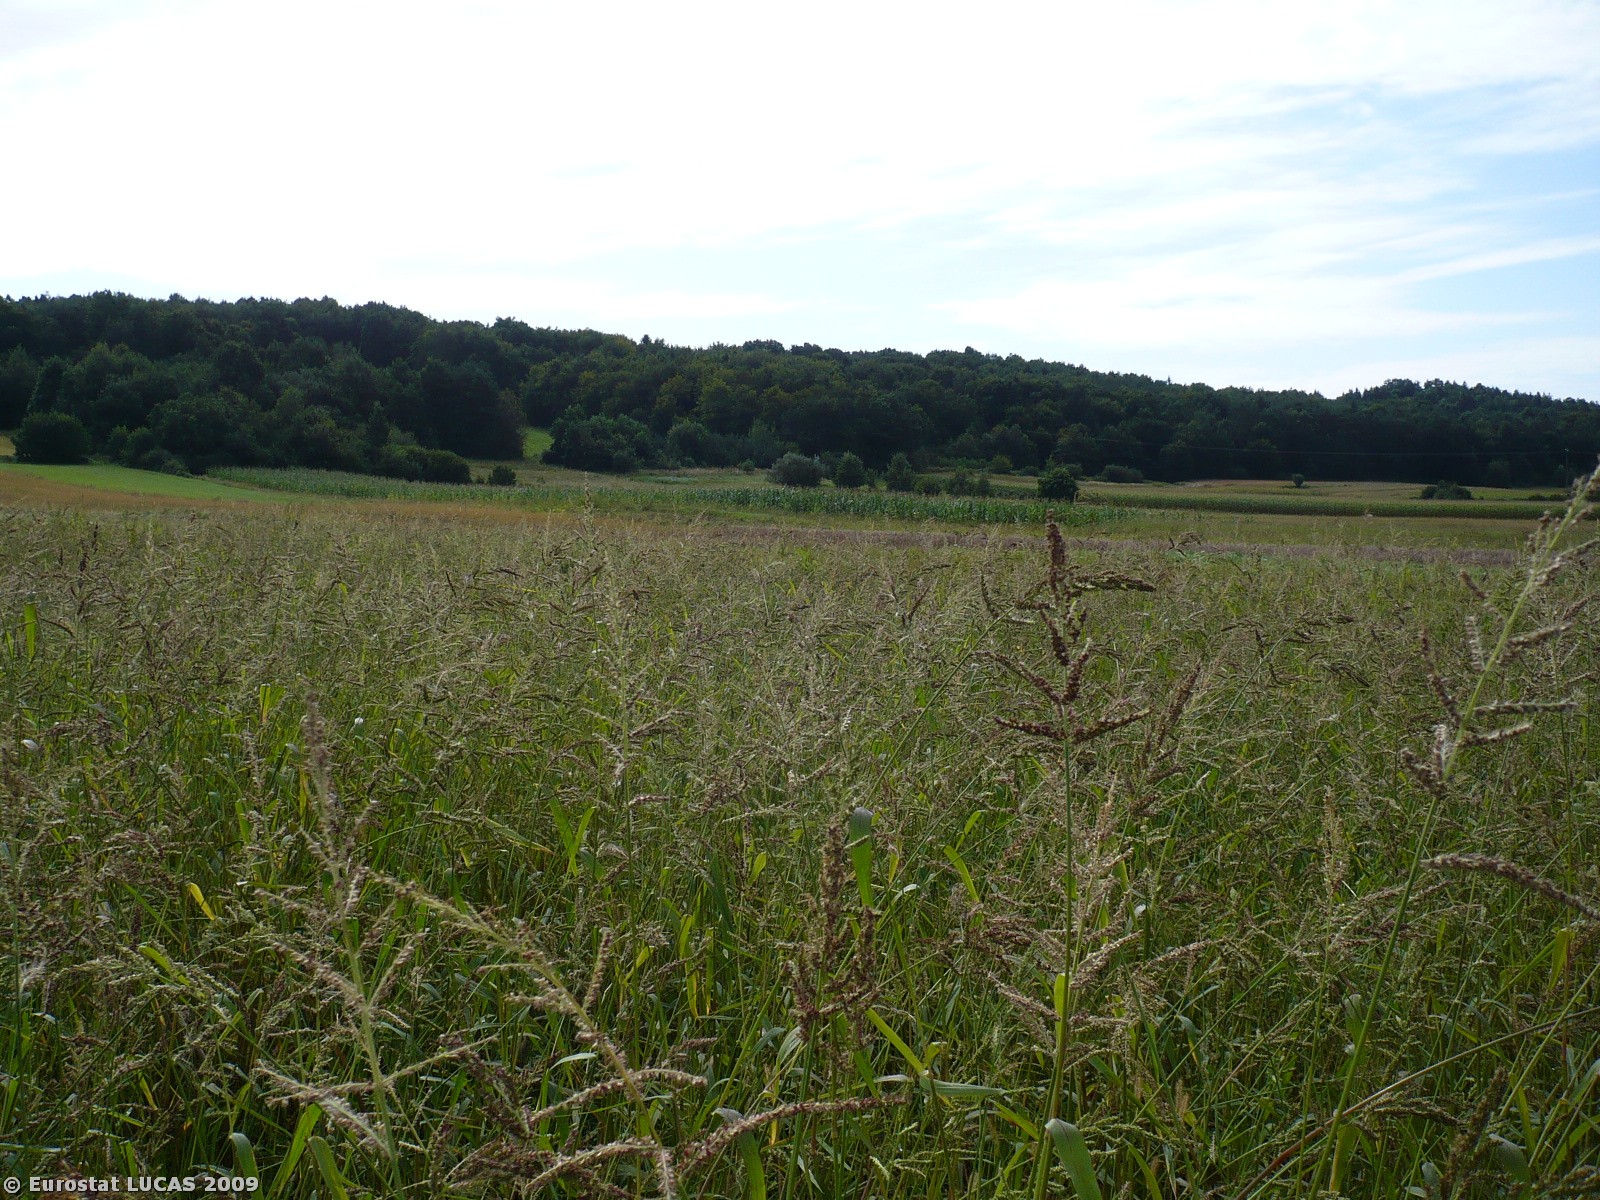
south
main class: Cropland
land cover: Other fresh vegetables
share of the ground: > 75 %
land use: Agriculture (excluding fallow land and kitchen gardens)
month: July
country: SI
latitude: 46.7751
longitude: 16.0642
